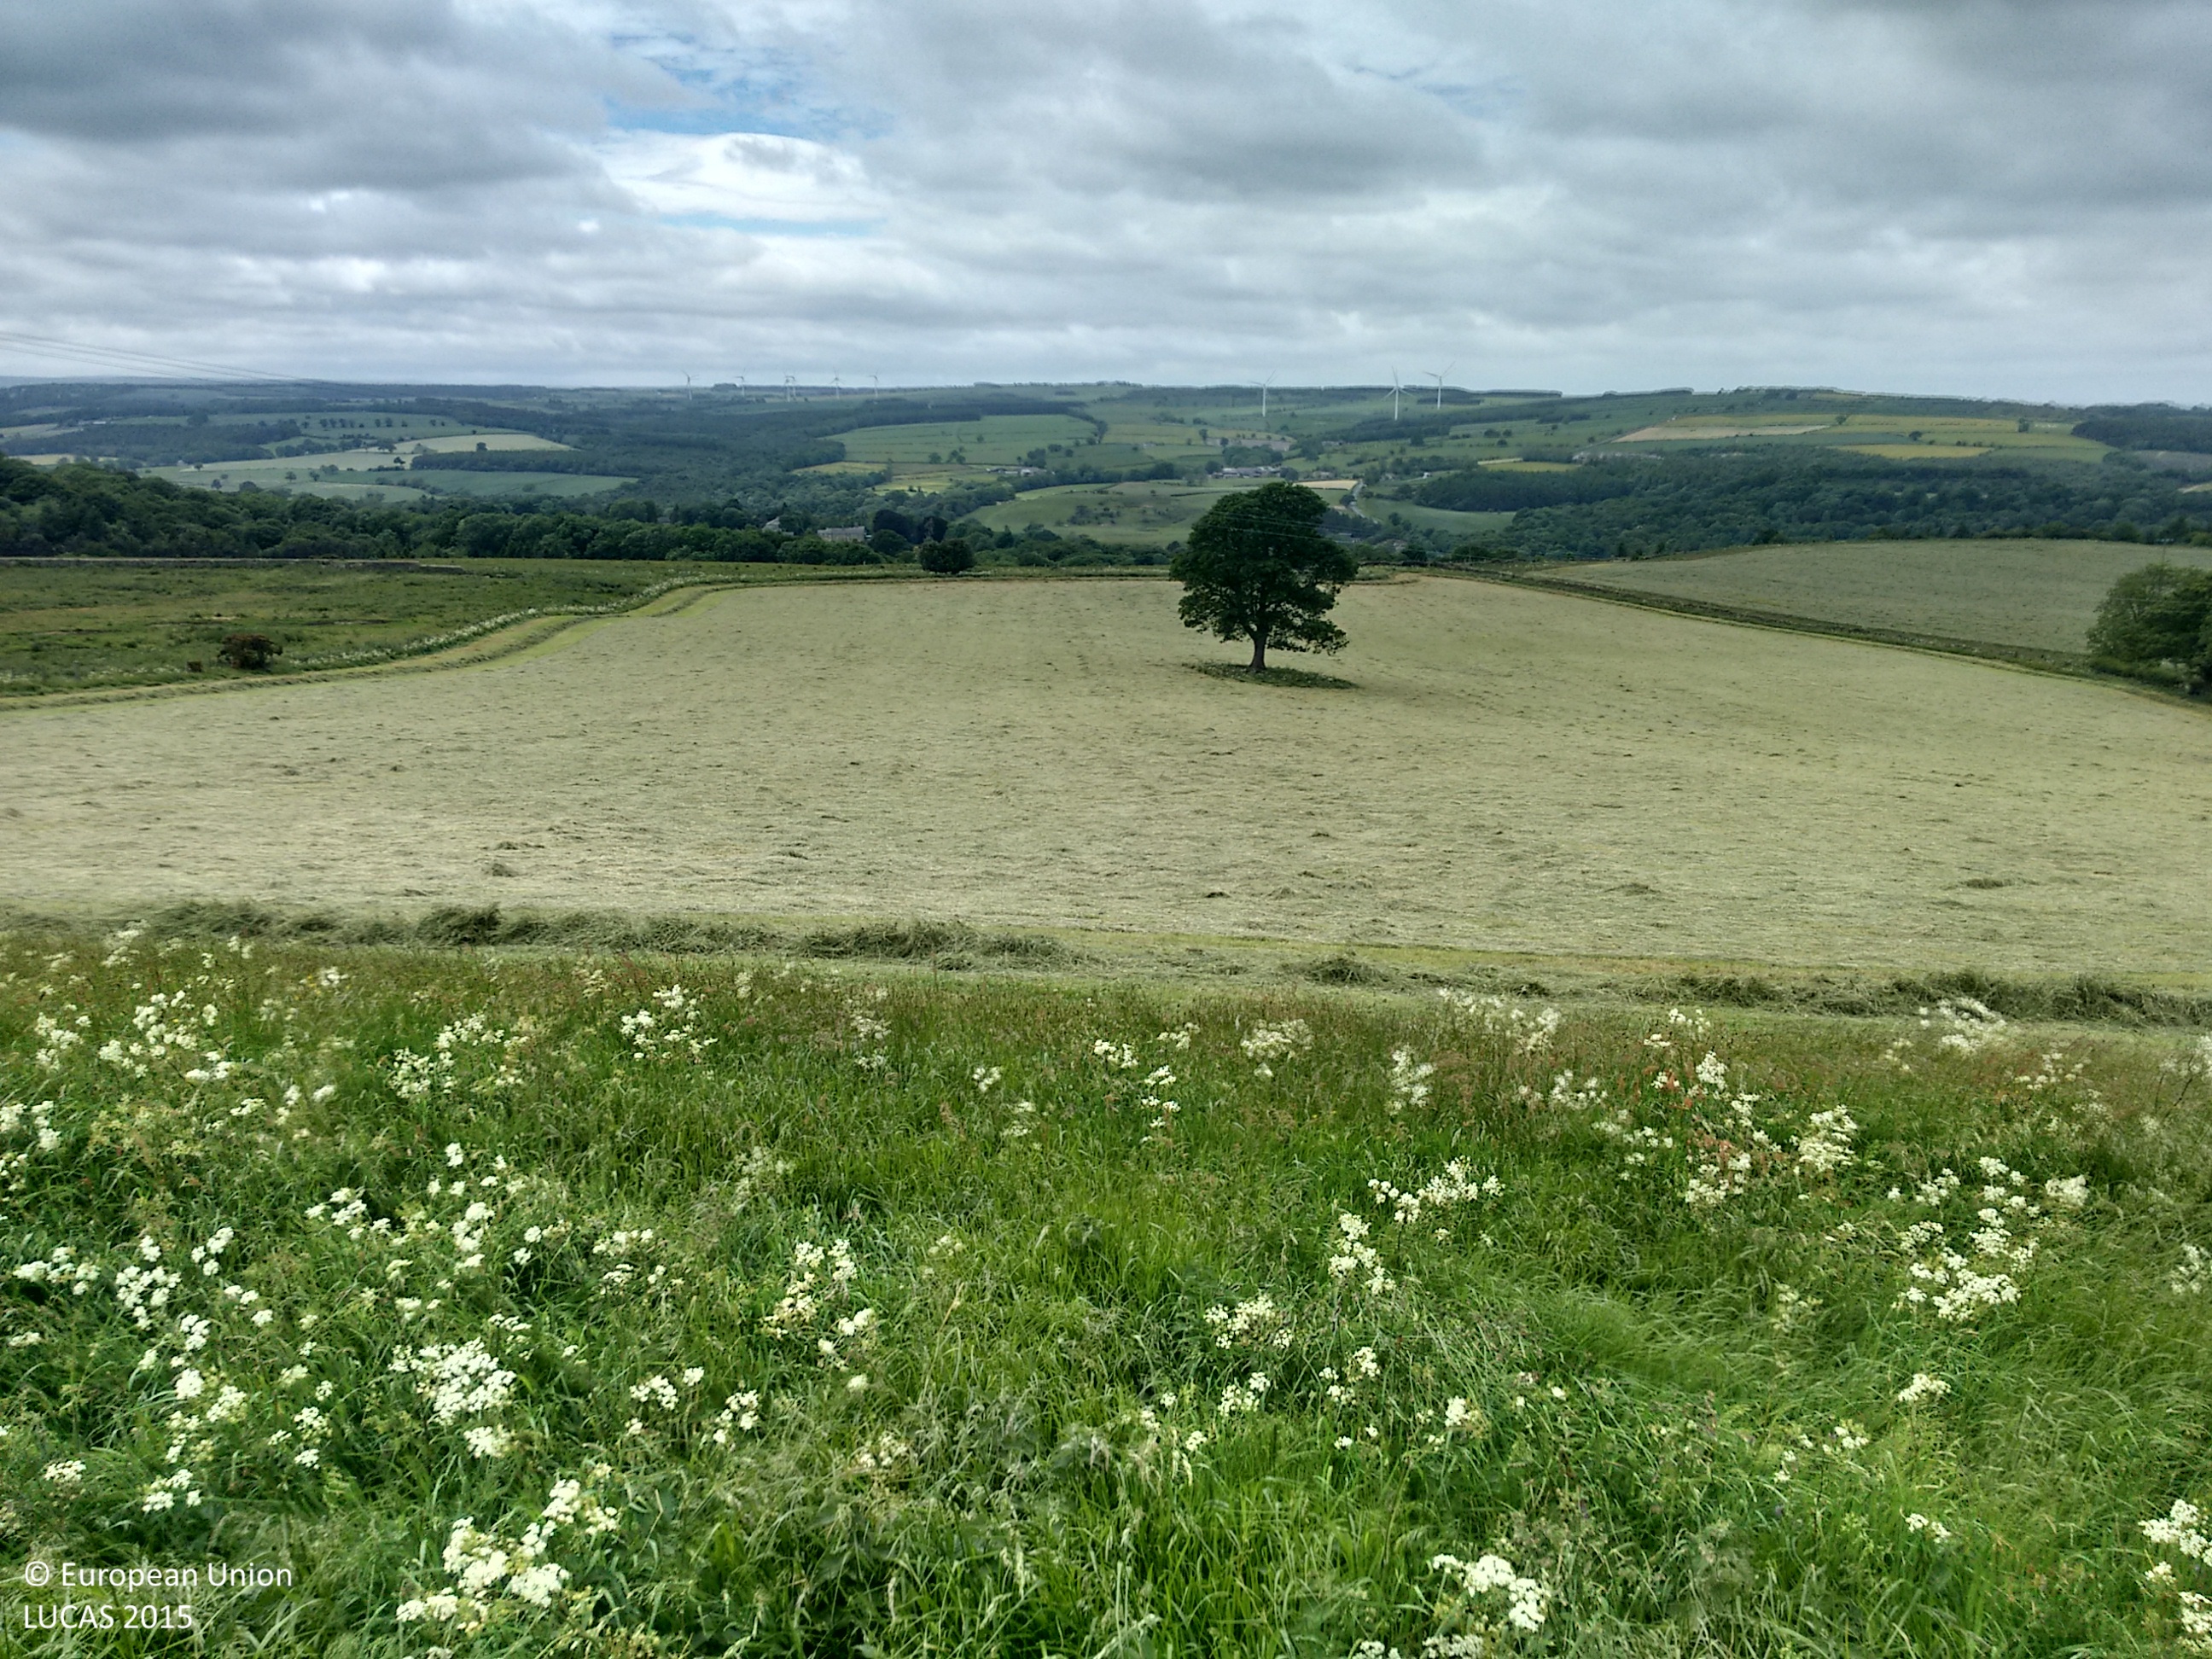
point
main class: Grassland
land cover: Grassland without tree/shrub cover
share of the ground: > 75 %
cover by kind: herbaceous plants 100 %
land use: Agriculture (excluding fallow land and kitchen gardens)
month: June
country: GB
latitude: 54.8931
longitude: -1.8238
